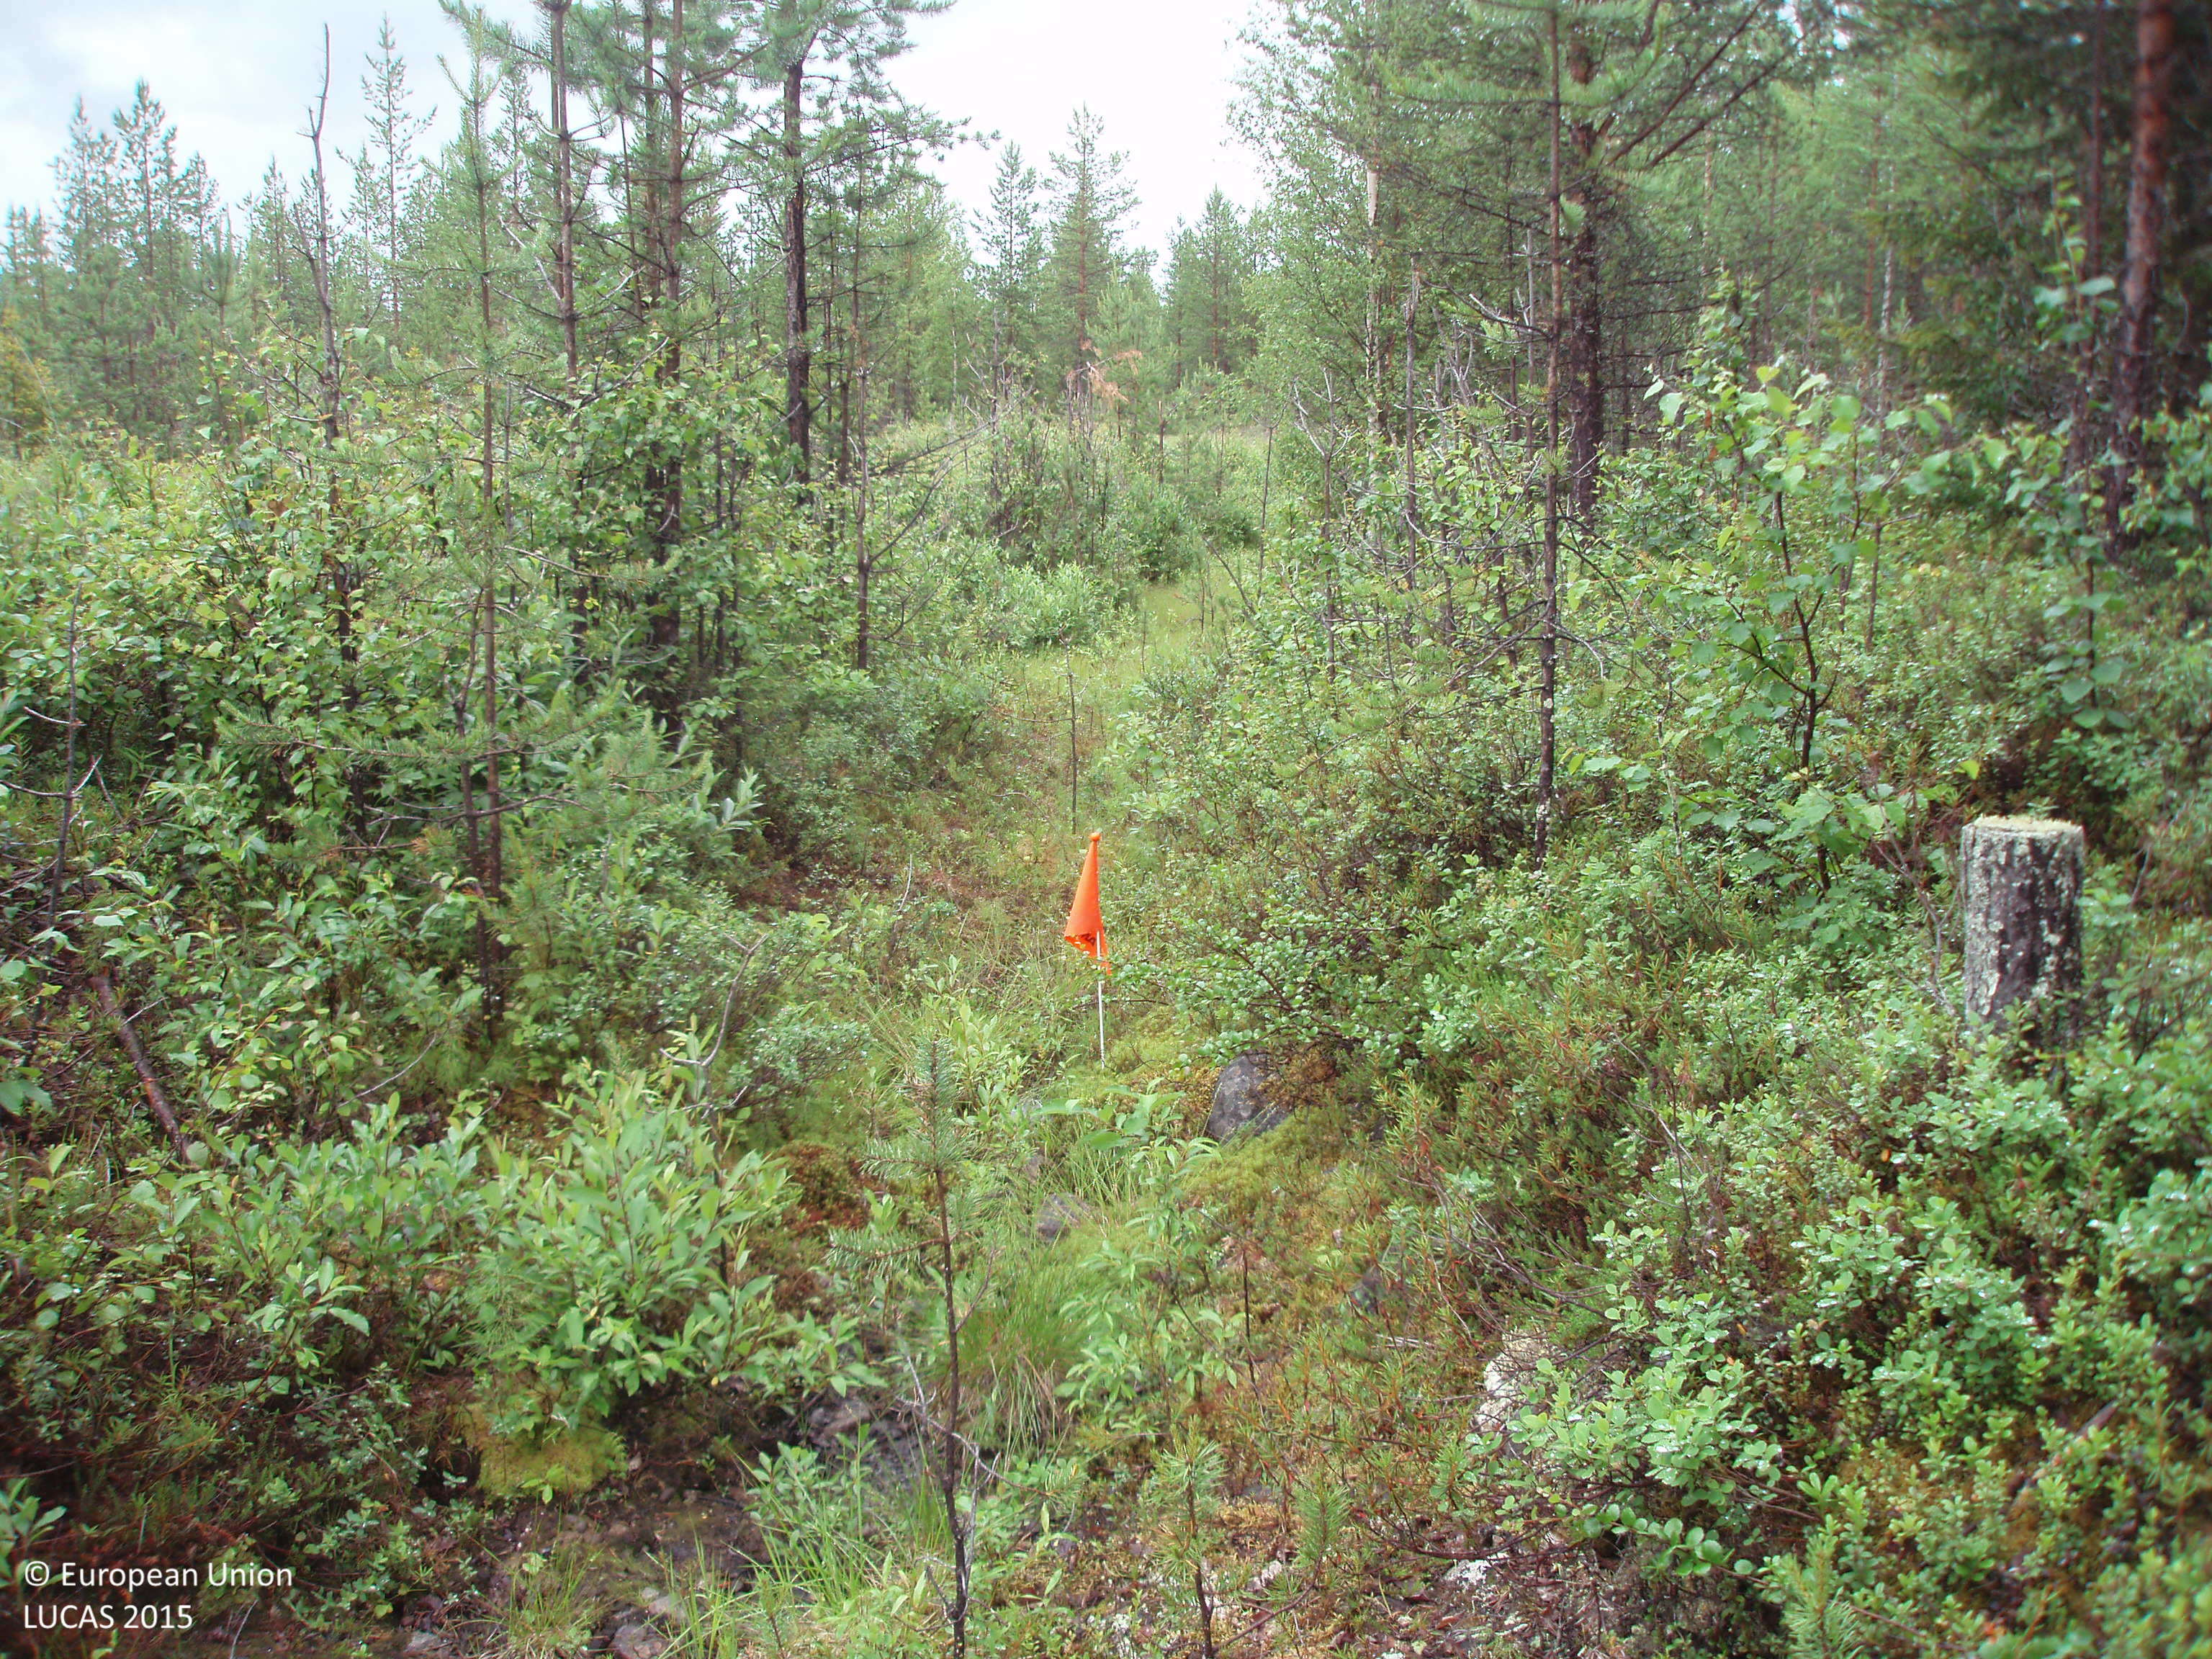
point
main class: Woodland
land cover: Pine dominated coniferous woodland
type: boreal forest
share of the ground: 50 - 75 %
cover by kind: shrubs 50 %, coniferous forest trees 45 %, broadleaved forest trees 5 %
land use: Forestry
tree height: > 5 m
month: July
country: FI
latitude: 66.6405
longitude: 28.0050
